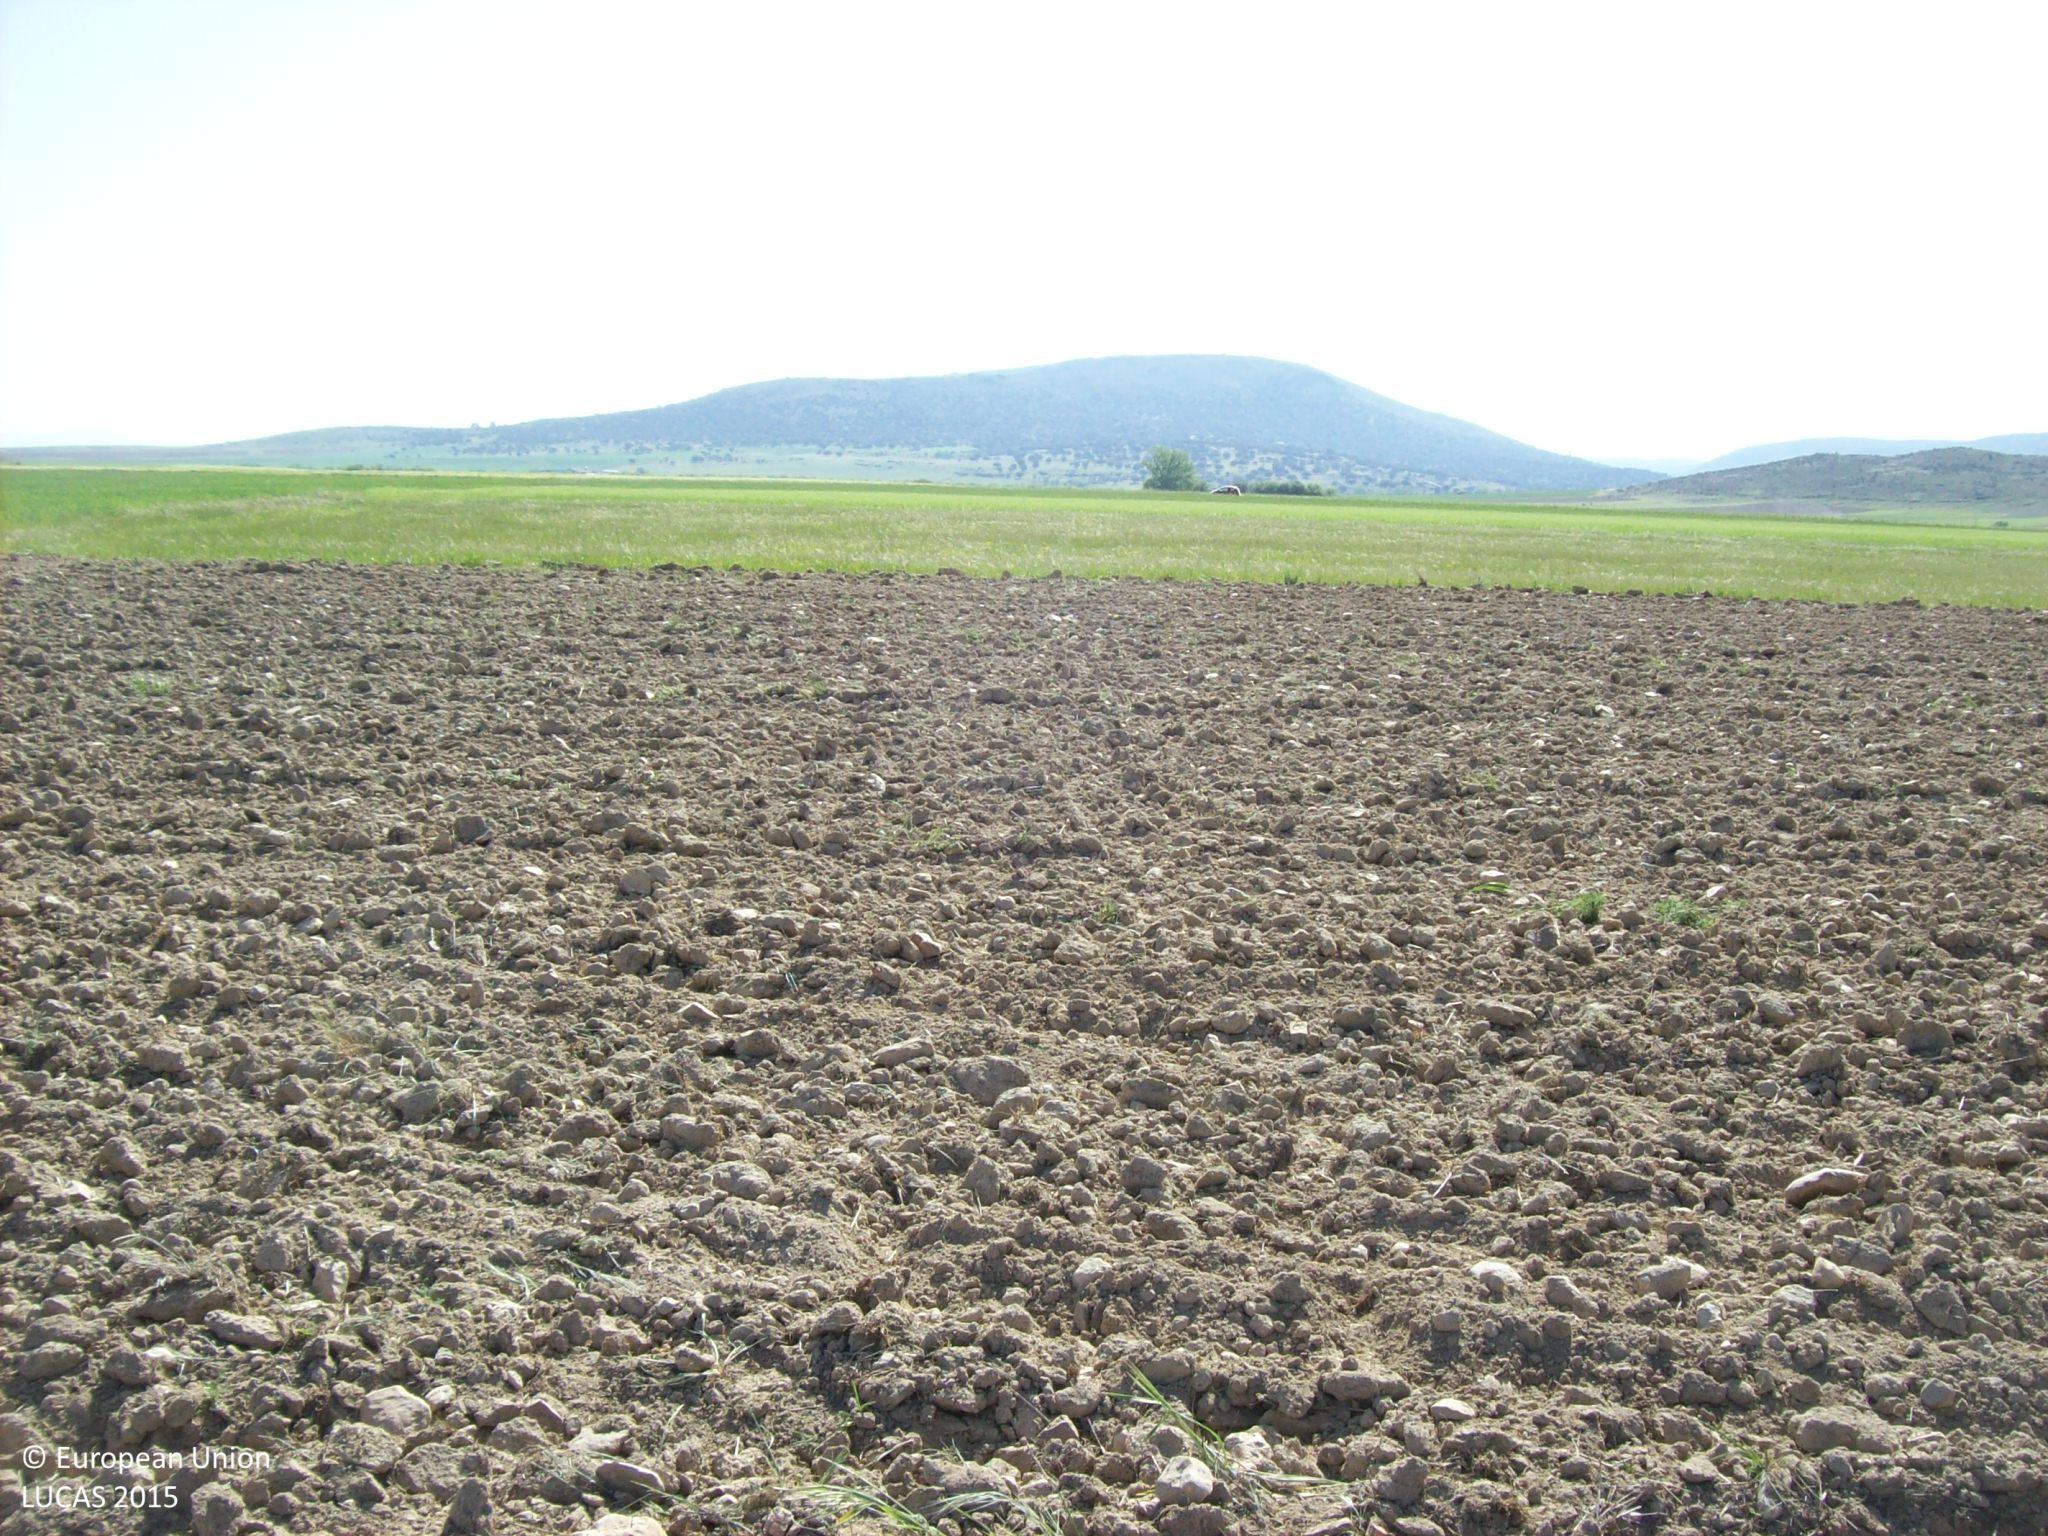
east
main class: Grassland
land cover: Spontaneously vegetated surfaces
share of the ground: 10 - 25 %
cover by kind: unconsolidated bare surface 70 %, herbaceous plants 15 %
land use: Fallow land
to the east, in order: Spontaneously vegetated surfaces; Other bare soil; Spontaneously vegetated surfaces; Grass margins; Barley; Grass margins; Common wheat; Grass margins; Tracks; Grass margins; Common wheat
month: May
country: ES
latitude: 40.5611
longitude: -4.8554
